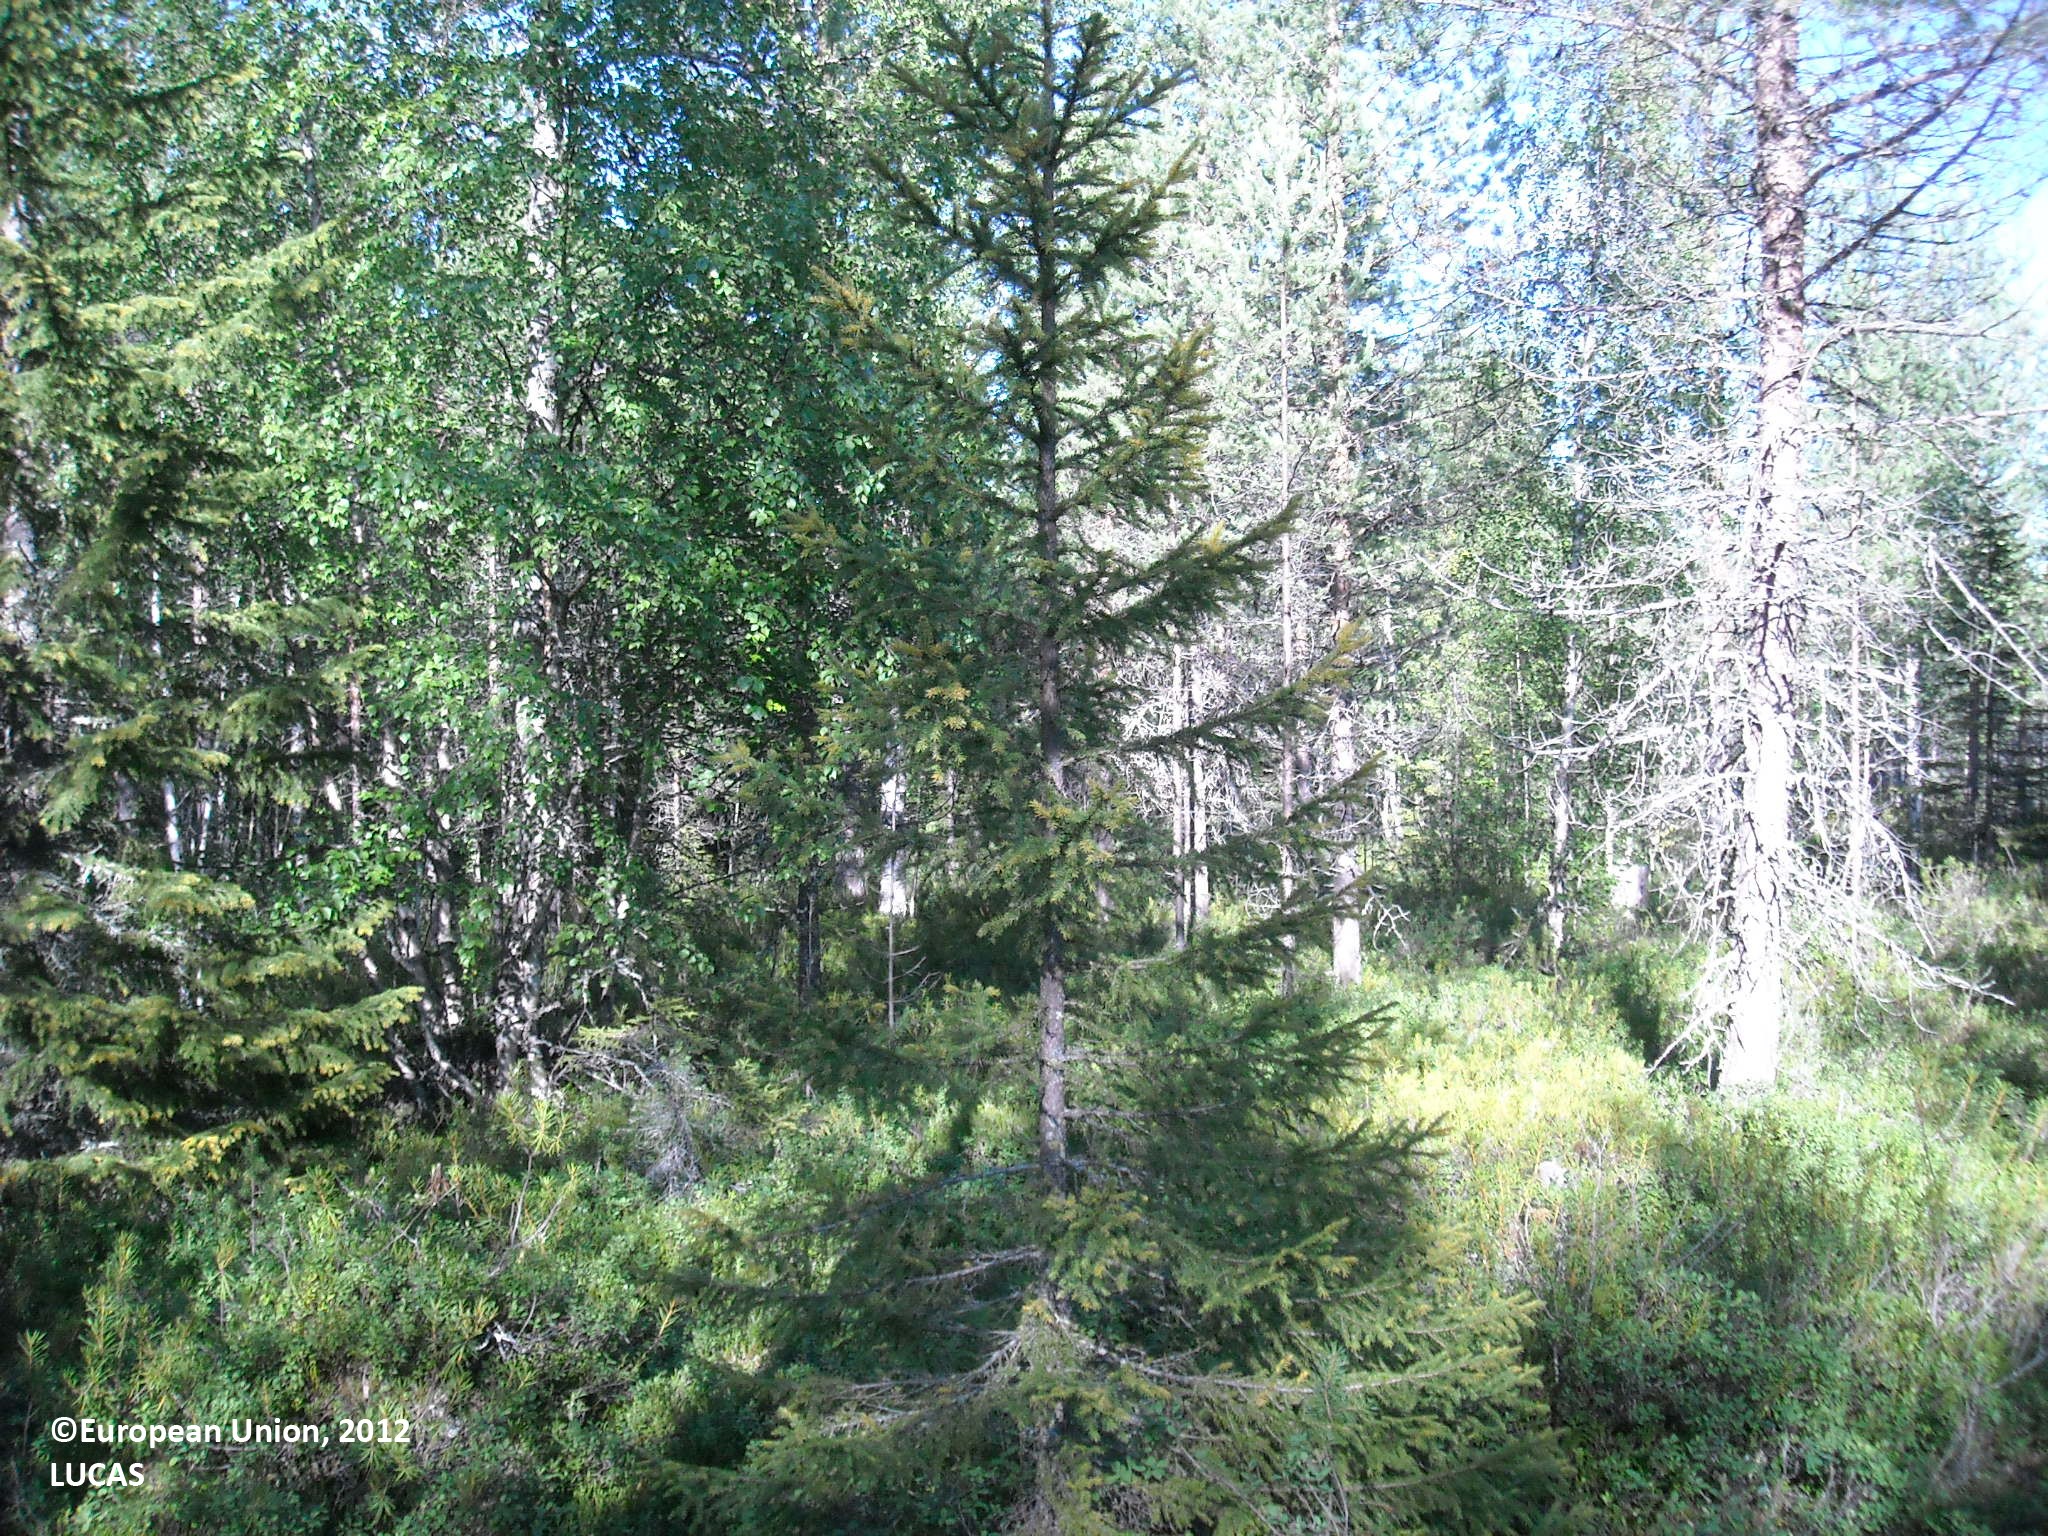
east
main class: Woodland
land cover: Other mixed woodland
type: boreal forest
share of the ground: 50 - 75 %
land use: Forestry
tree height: > 5 m
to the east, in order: Other mixed woodland; Paved roads, cycling and walking lanes; Other mixed woodland; Other coniferous woodland
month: July
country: FI
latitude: 65.1731
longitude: 27.7511
